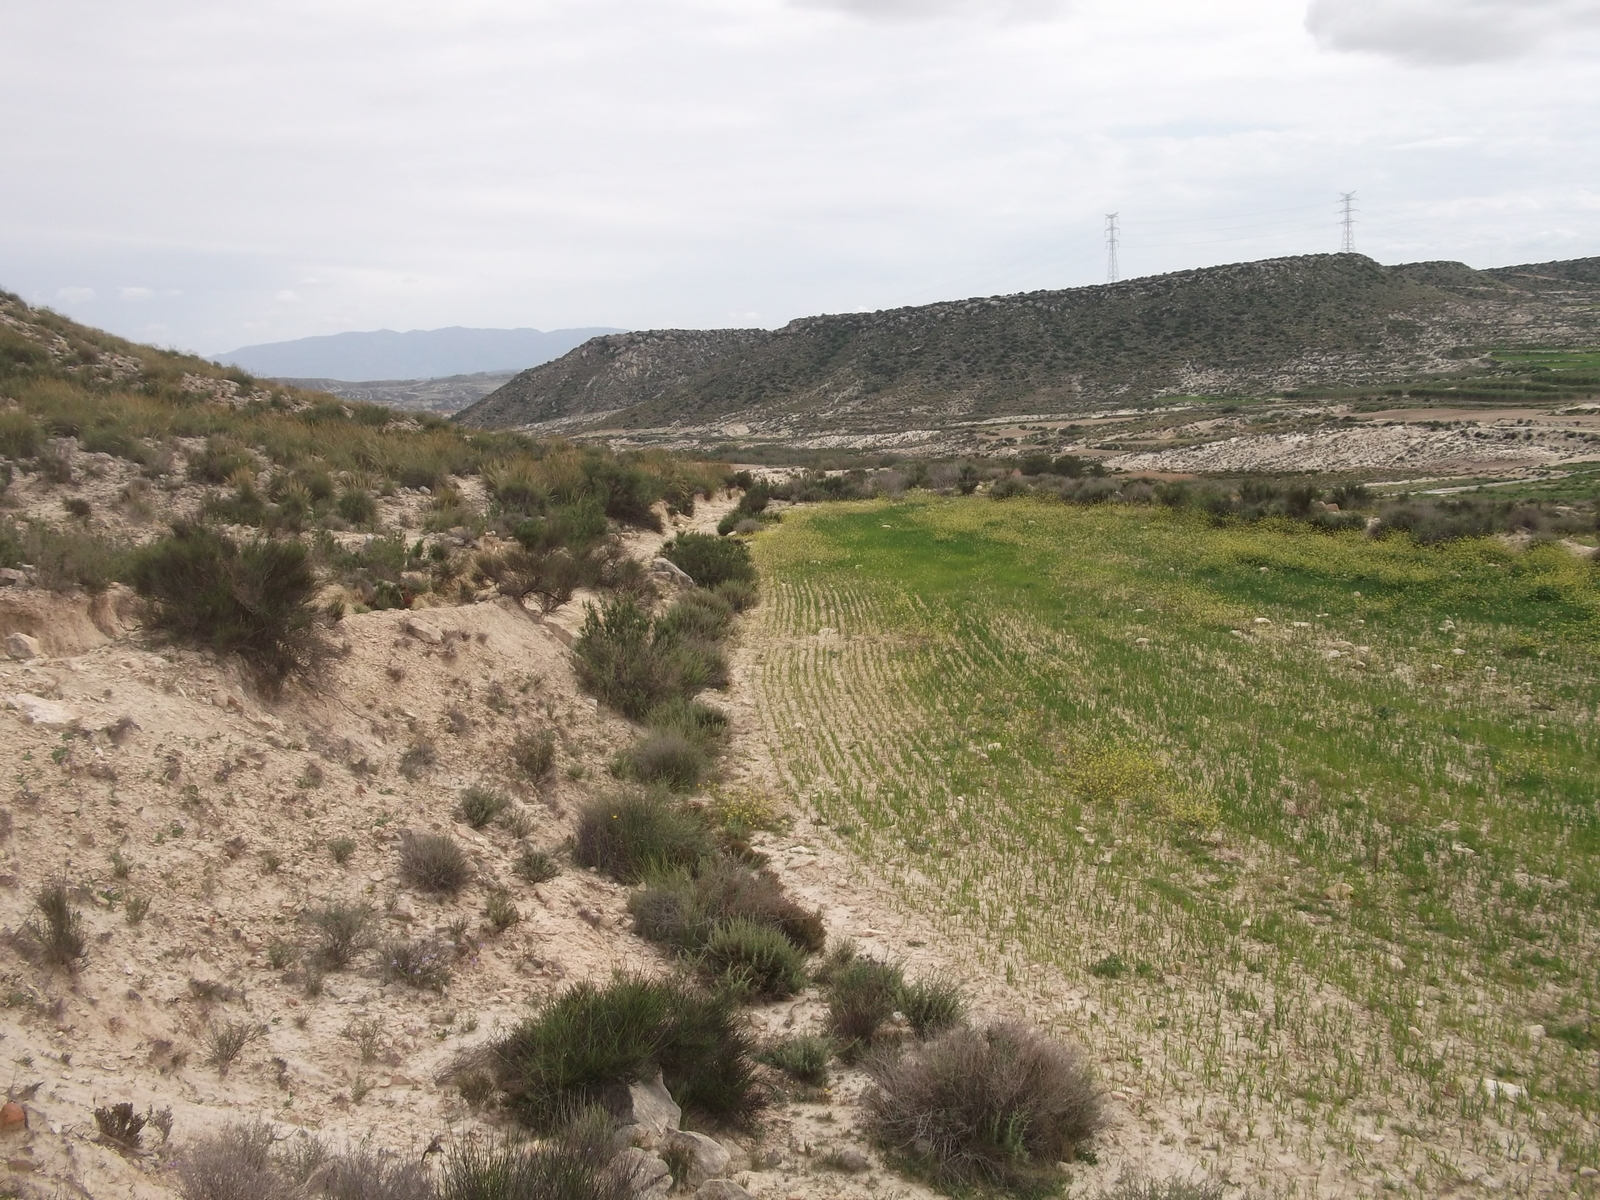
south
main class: Shrubland
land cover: Shrubland without tree cover
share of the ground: 10 - 25 %
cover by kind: consolidated bare surface 80 %, shrubs 20 %
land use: Semi-natural and natural areas not in use
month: April
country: ES
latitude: 38.0663
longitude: -1.3957
